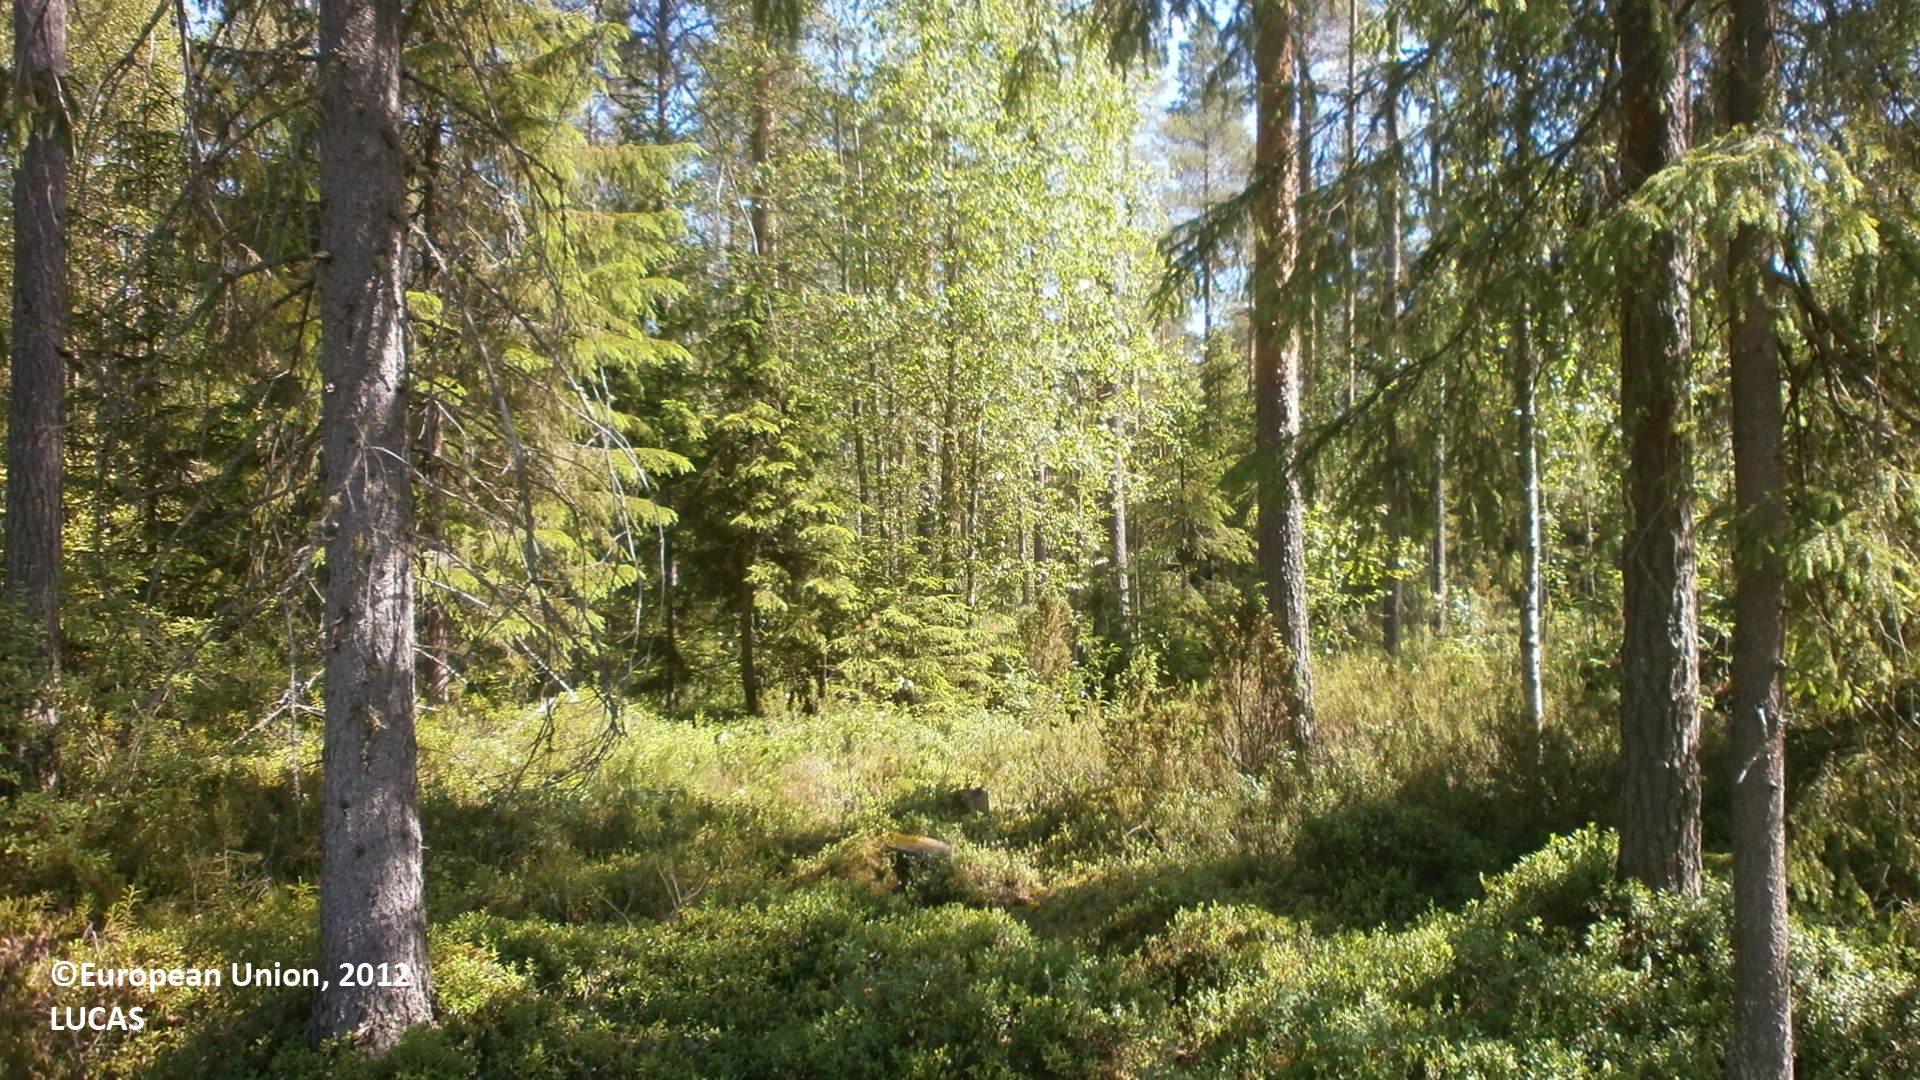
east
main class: Woodland
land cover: Pine dominated coniferous woodland
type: boreal forest
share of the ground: 50 - 75 %
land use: Forestry
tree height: > 5 m
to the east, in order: Pine dominated coniferous woodland; Ditches and canals; Pine dominated coniferous woodland; Ditches and canals; Pine dominated mixed woodland; Ditches and canals; Pine dominated mixed woodland; Ditches and canals; Pine dominated mixed woodland; Ditches and canals; Pine dominated mixed woodland
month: July
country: FI
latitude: 63.9746
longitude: 24.8092
